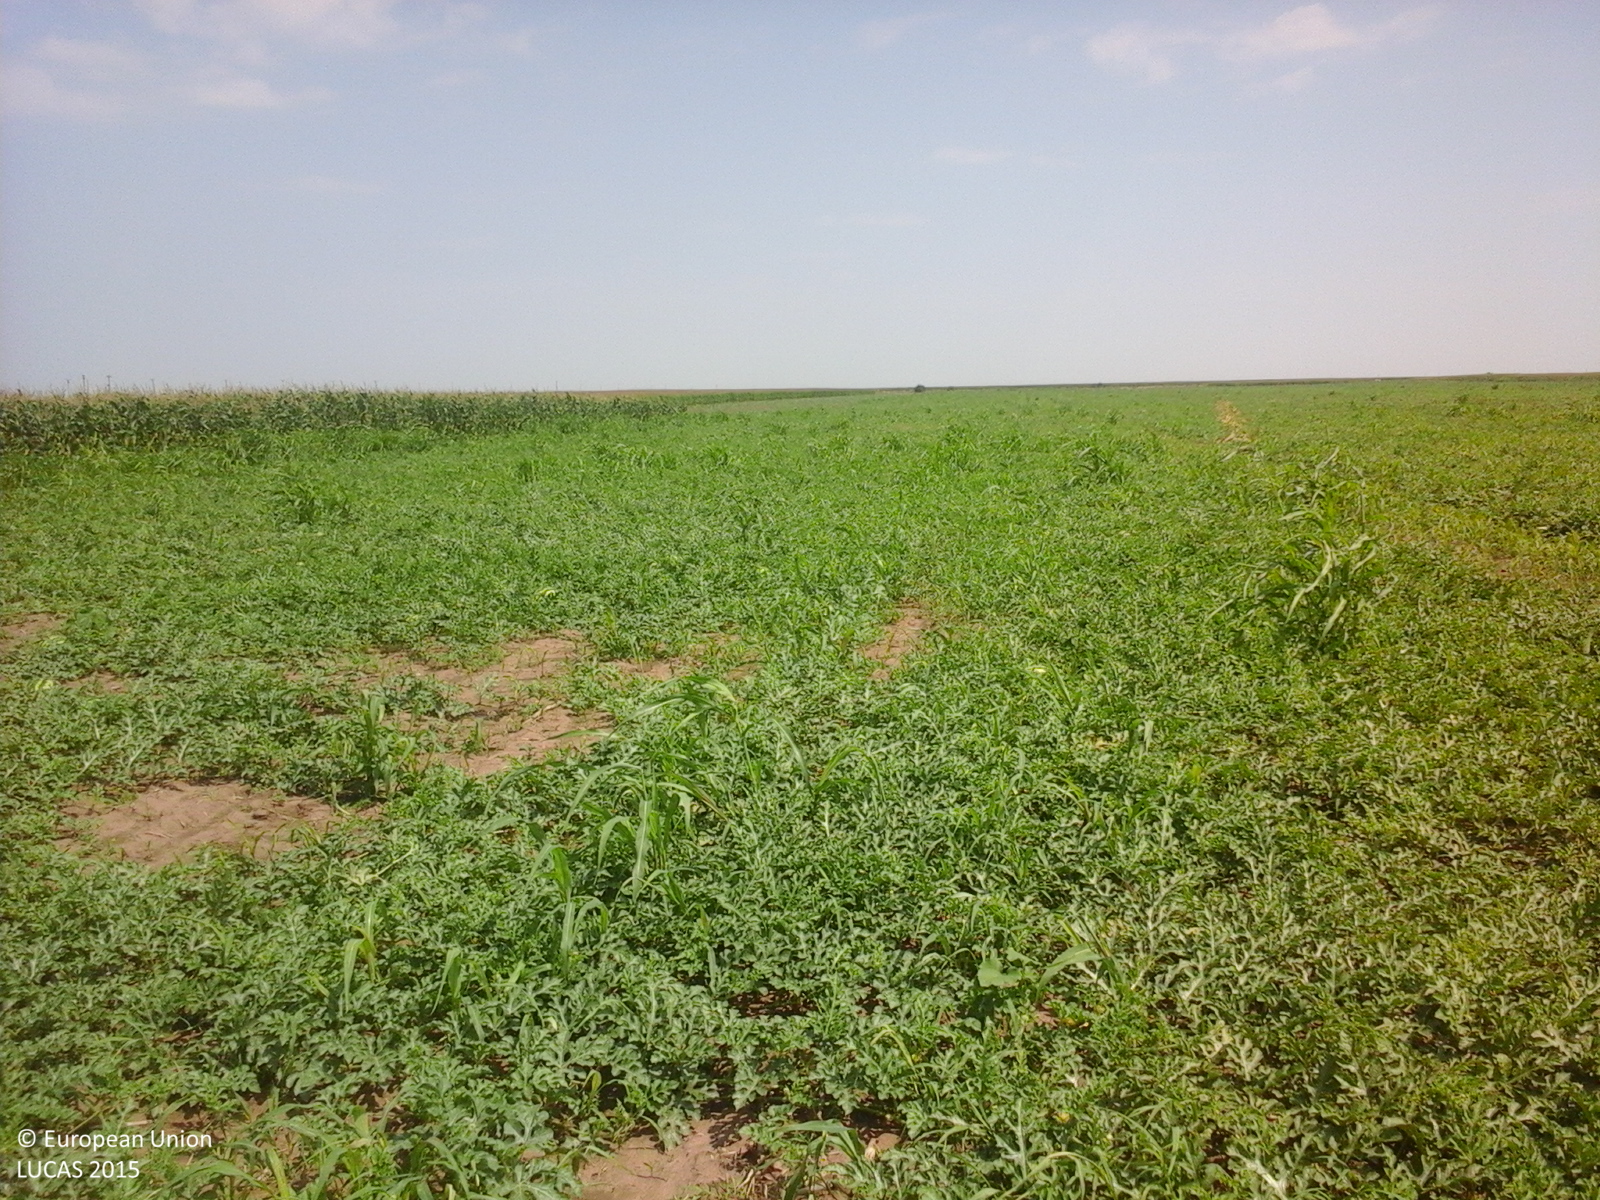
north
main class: Cropland
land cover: Other fresh vegetables
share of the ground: > 75 %
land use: Agriculture (excluding fallow land and kitchen gardens)
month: July
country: RO
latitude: 44.6412
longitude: 27.1417
